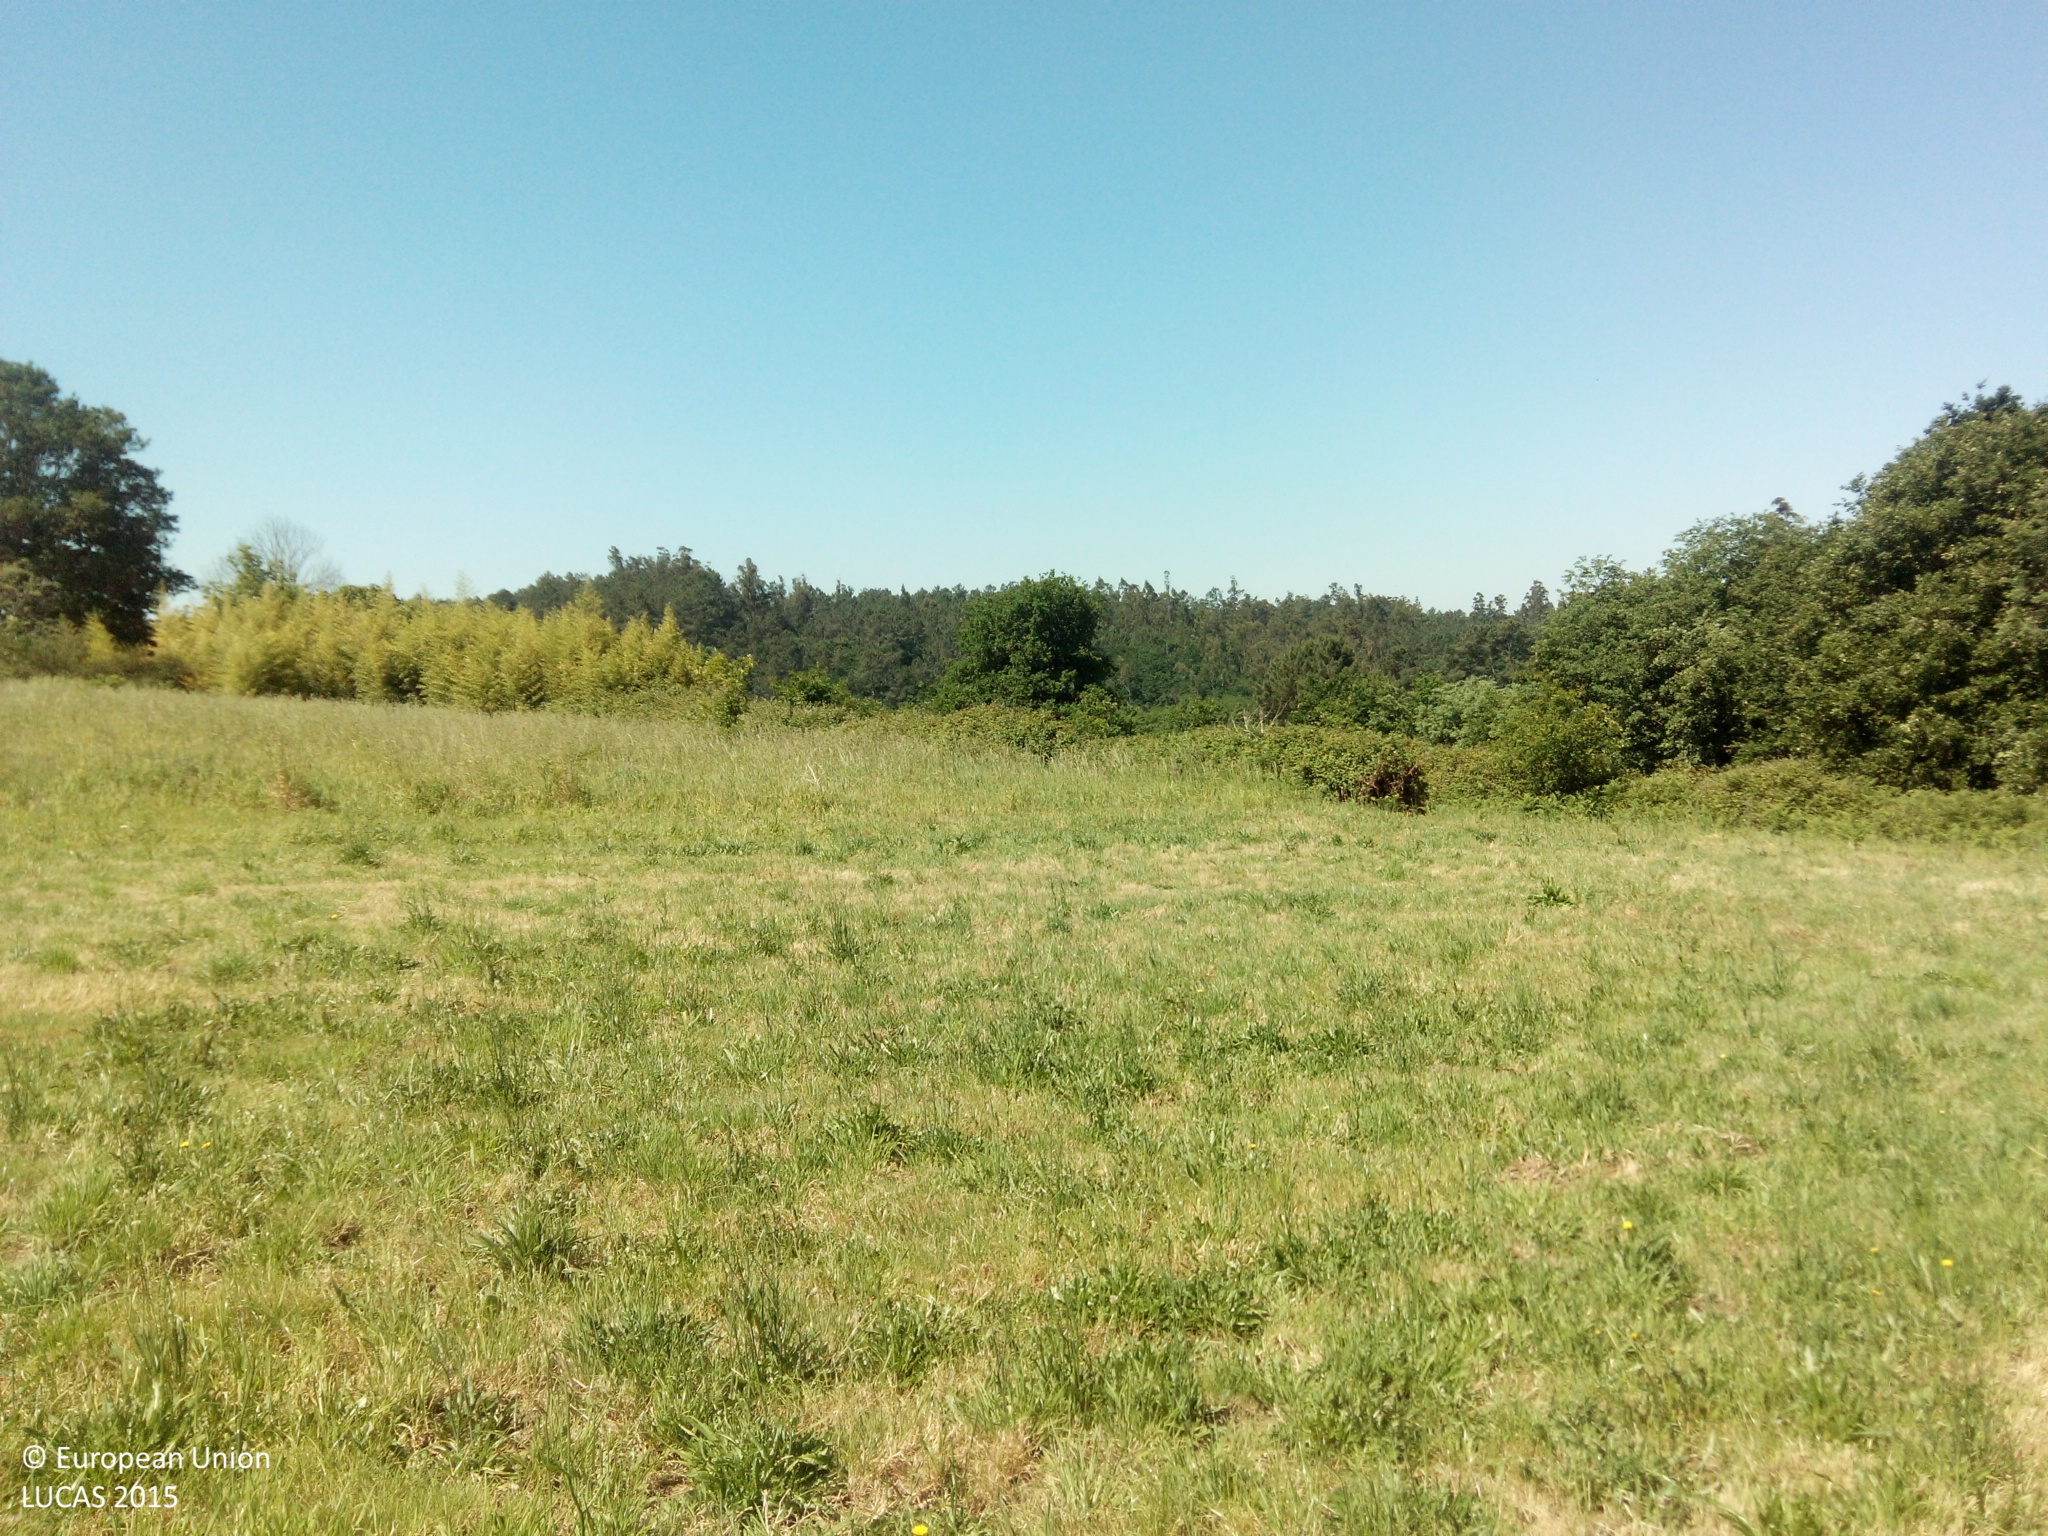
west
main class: Grassland
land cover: Grassland without tree/shrub cover
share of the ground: > 75 %
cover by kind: herbaceous plants 100 %
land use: Agriculture (excluding fallow land and kitchen gardens)
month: May
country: ES
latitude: 42.8021
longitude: -8.4797
